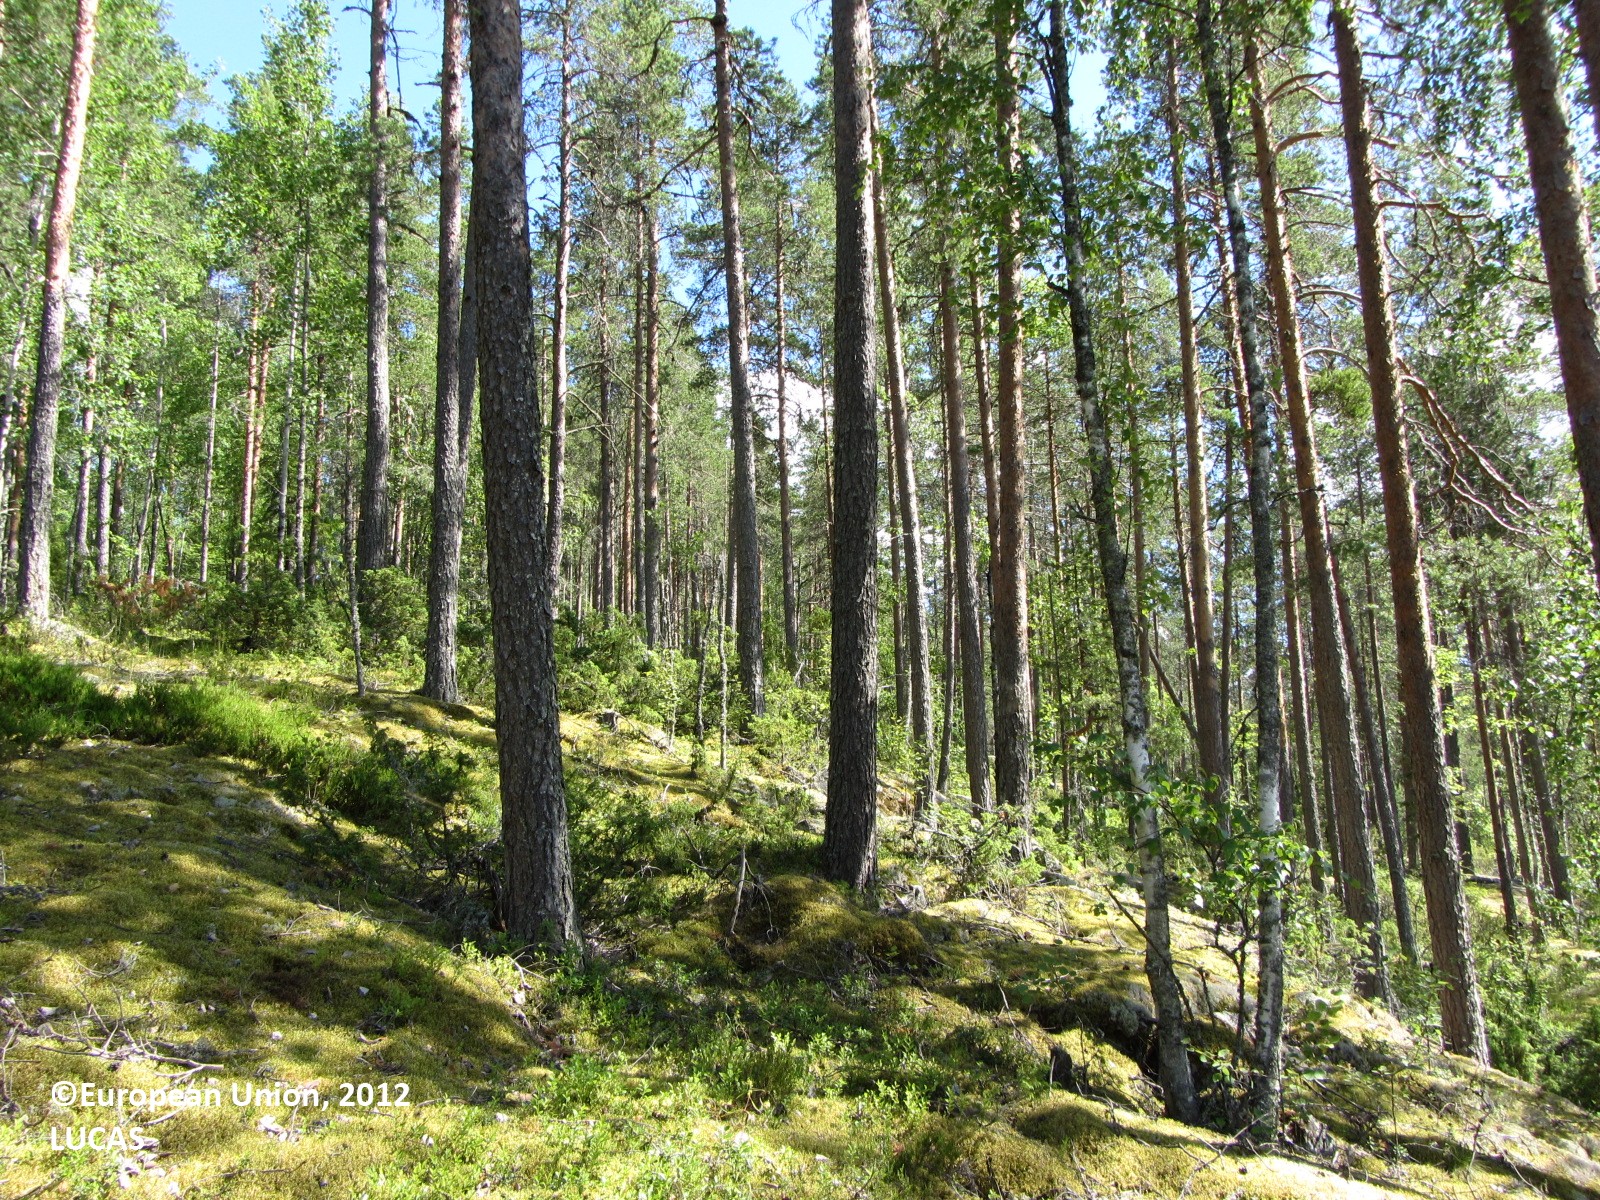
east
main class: Woodland
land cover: Pine dominated coniferous woodland
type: boreal forest
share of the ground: > 75 %
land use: Forestry
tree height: > 5 m
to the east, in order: Pine dominated coniferous woodland; Pine dominated mixed woodland; Other mixed woodland; Tracks; Other mixed woodland; Pine dominated mixed woodland; Tracks; Pine dominated mixed woodland; Tracks; Pine dominated mixed woodland; Tracks; Other mixed woodland; Shrubland with sparse tree cover; Other mixed woodland
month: July
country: FI
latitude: 63.0650
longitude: 25.6022
